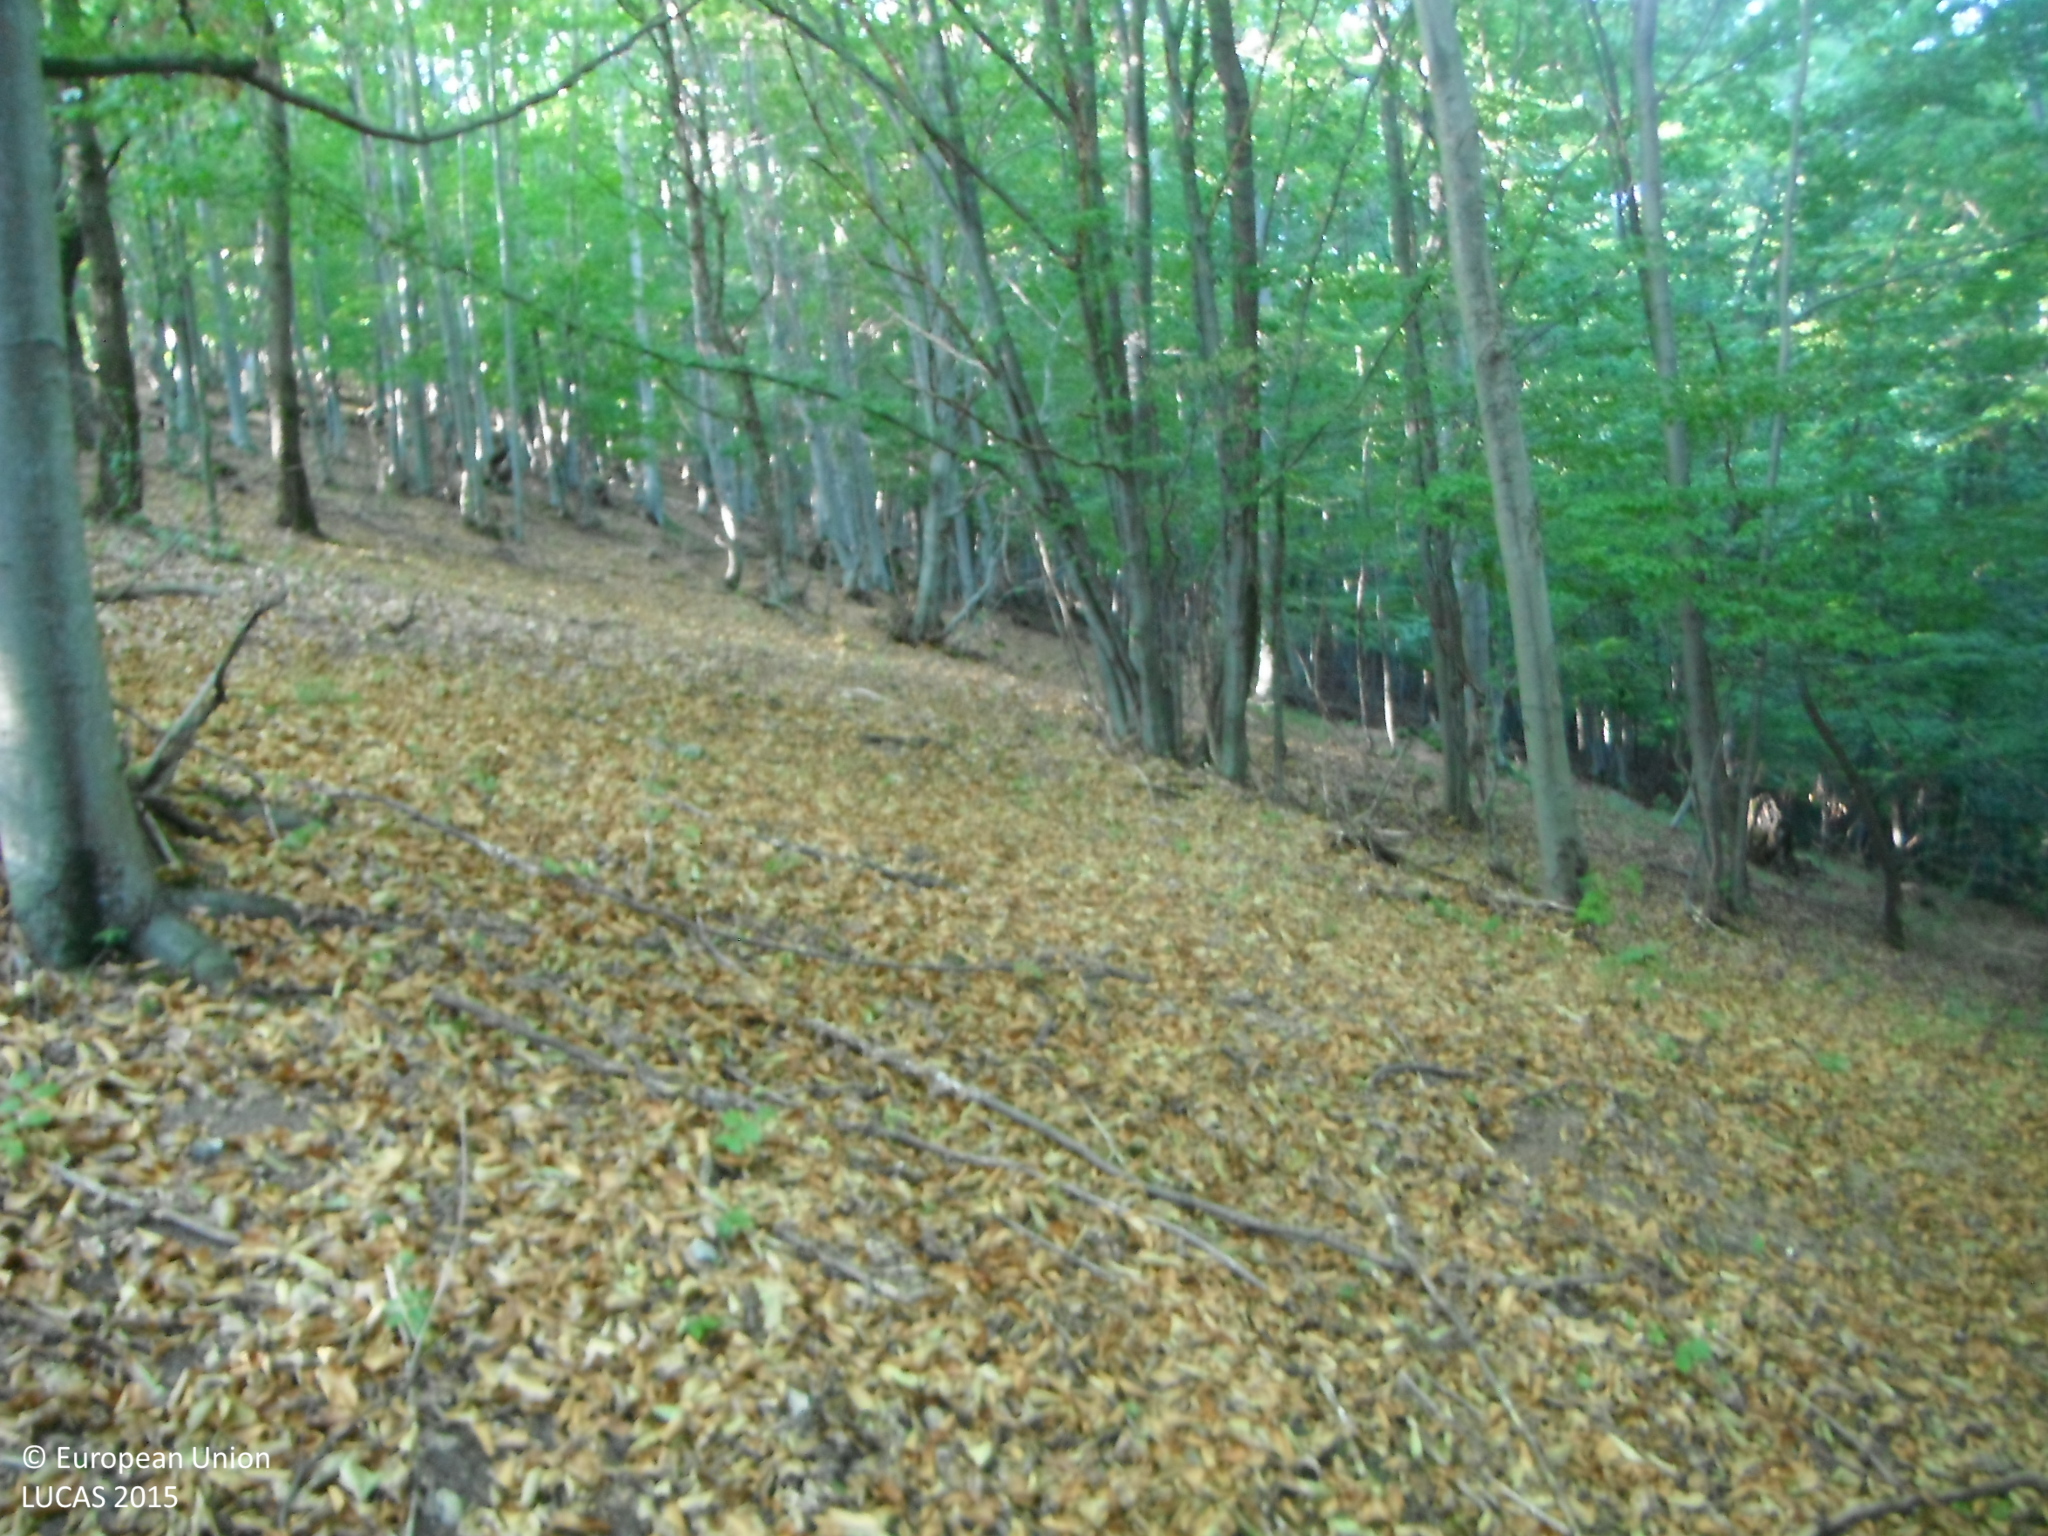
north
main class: Woodland
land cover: Broadleaved woodland
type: beech forest
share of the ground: > 75 %
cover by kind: broadleaved forest trees 90 %, shrubs 5 %
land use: Forestry
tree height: > 5 m
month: September
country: SK
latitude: 48.8316
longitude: 18.3125
